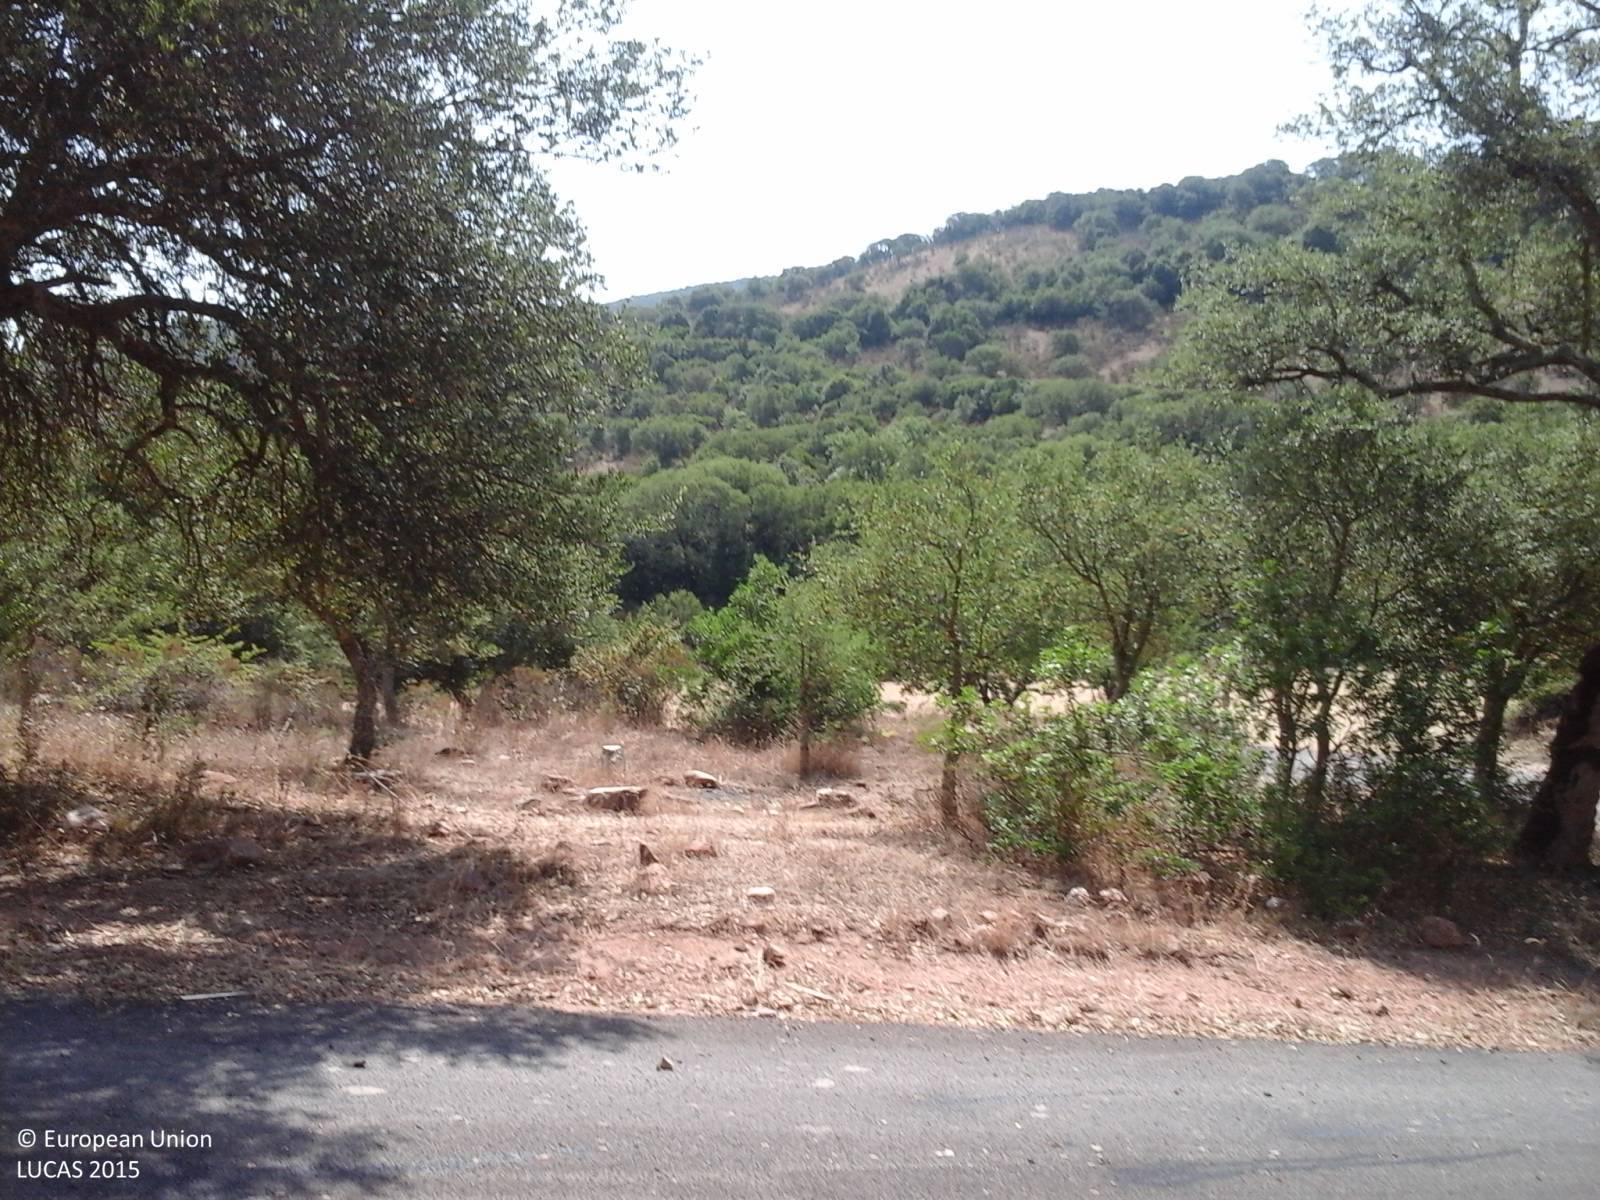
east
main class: Woodland
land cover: Broadleaved woodland
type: broadleaved evergreen forest
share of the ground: > 75 %
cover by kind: broadleaved forest trees 100 %
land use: Forestry
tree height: < 5 m
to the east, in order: Broadleaved woodland; Fences; Paved roads, cycling and walking lanes; Broadleaved woodland; Electric lines; Paved roads, cycling and walking lanes; Grass margins; Single bushes/trees; Fences; Durum wheat; Shrubland without tree cover; Ditches and canals; Fences; Broadleaved woodland
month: July
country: IT
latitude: 39.9349
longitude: 8.8711
